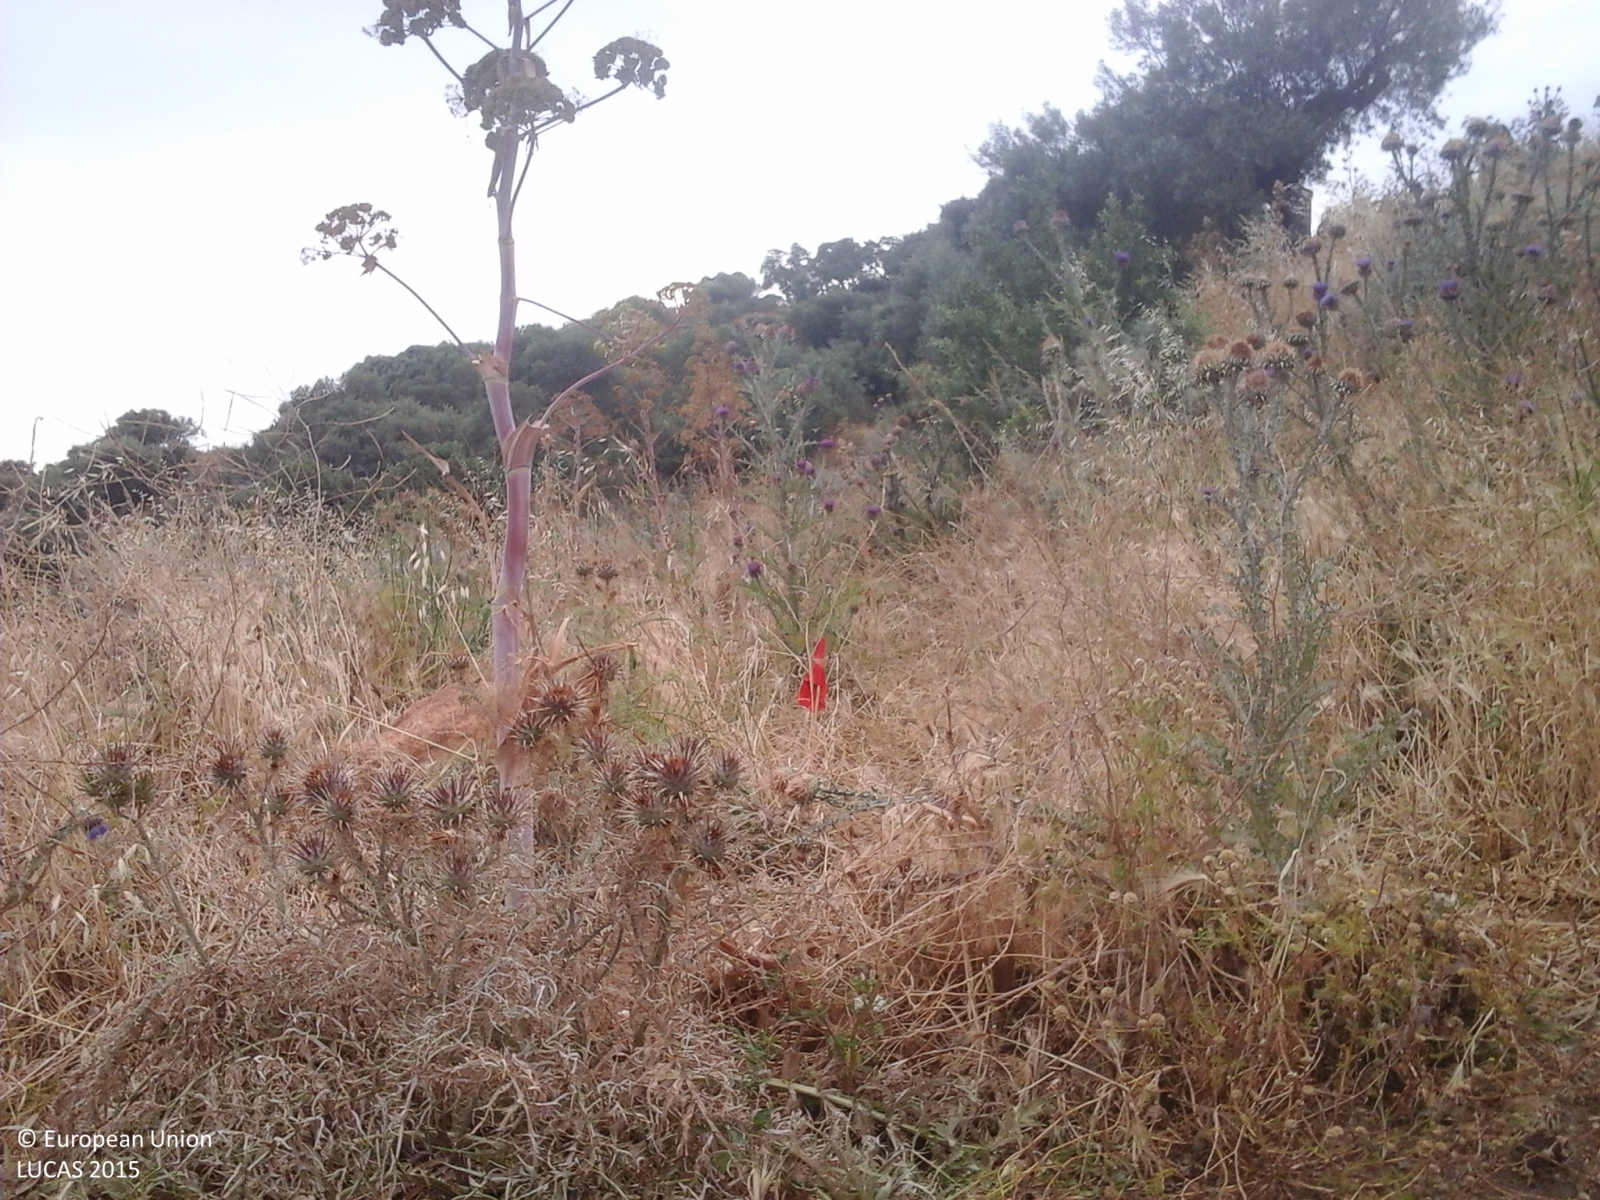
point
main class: Grassland
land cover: Grassland with sparse tree/shrub cover
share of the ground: > 75 %
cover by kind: herbaceous plants 75 %, unconsolidated bare surface 15 %, broadleaved forest trees 5 %, shrubs 5 %
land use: Agriculture (excluding fallow land and kitchen gardens)
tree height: < 5 m
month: June
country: IT
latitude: 37.7150
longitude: 14.4718
